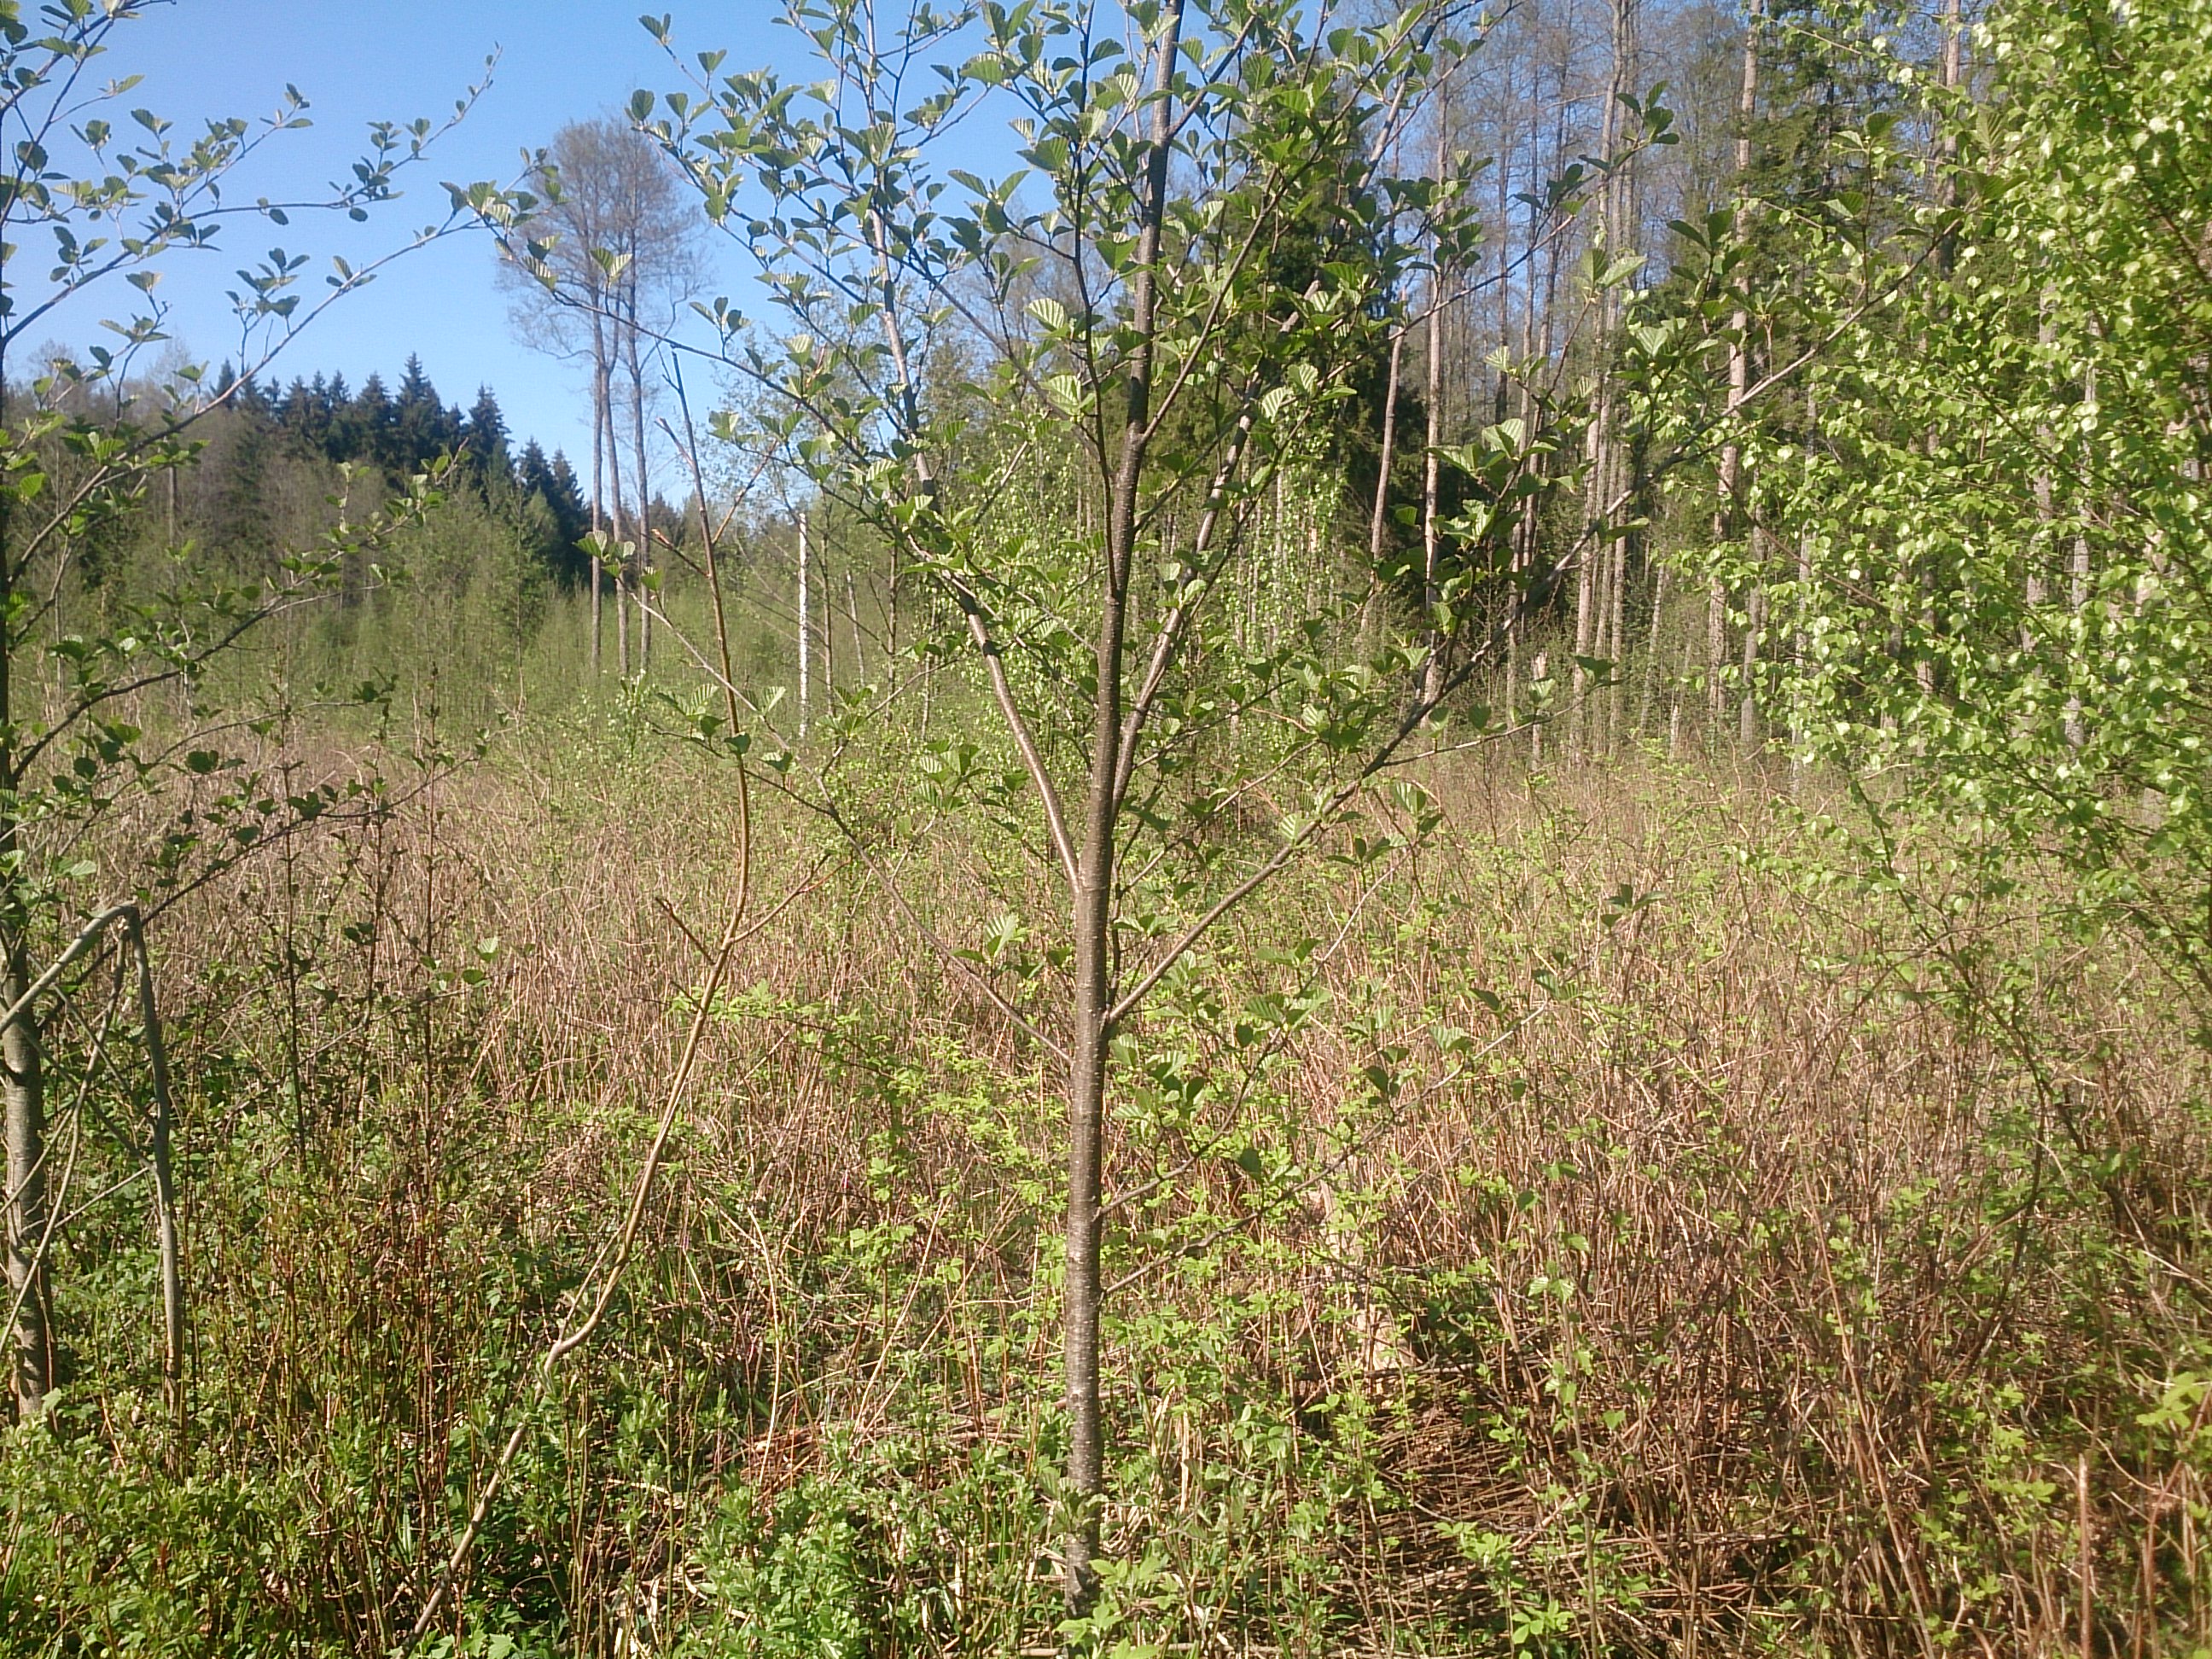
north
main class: Woodland
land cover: Broadleaved woodland
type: non-riverine alder, birch or aspen forest
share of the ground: > 75 %
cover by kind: broadleaved forest trees 50 %, shrubs 50 %
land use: Forestry
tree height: < 5 m
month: May
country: LV
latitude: 56.7388
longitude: 24.4308
